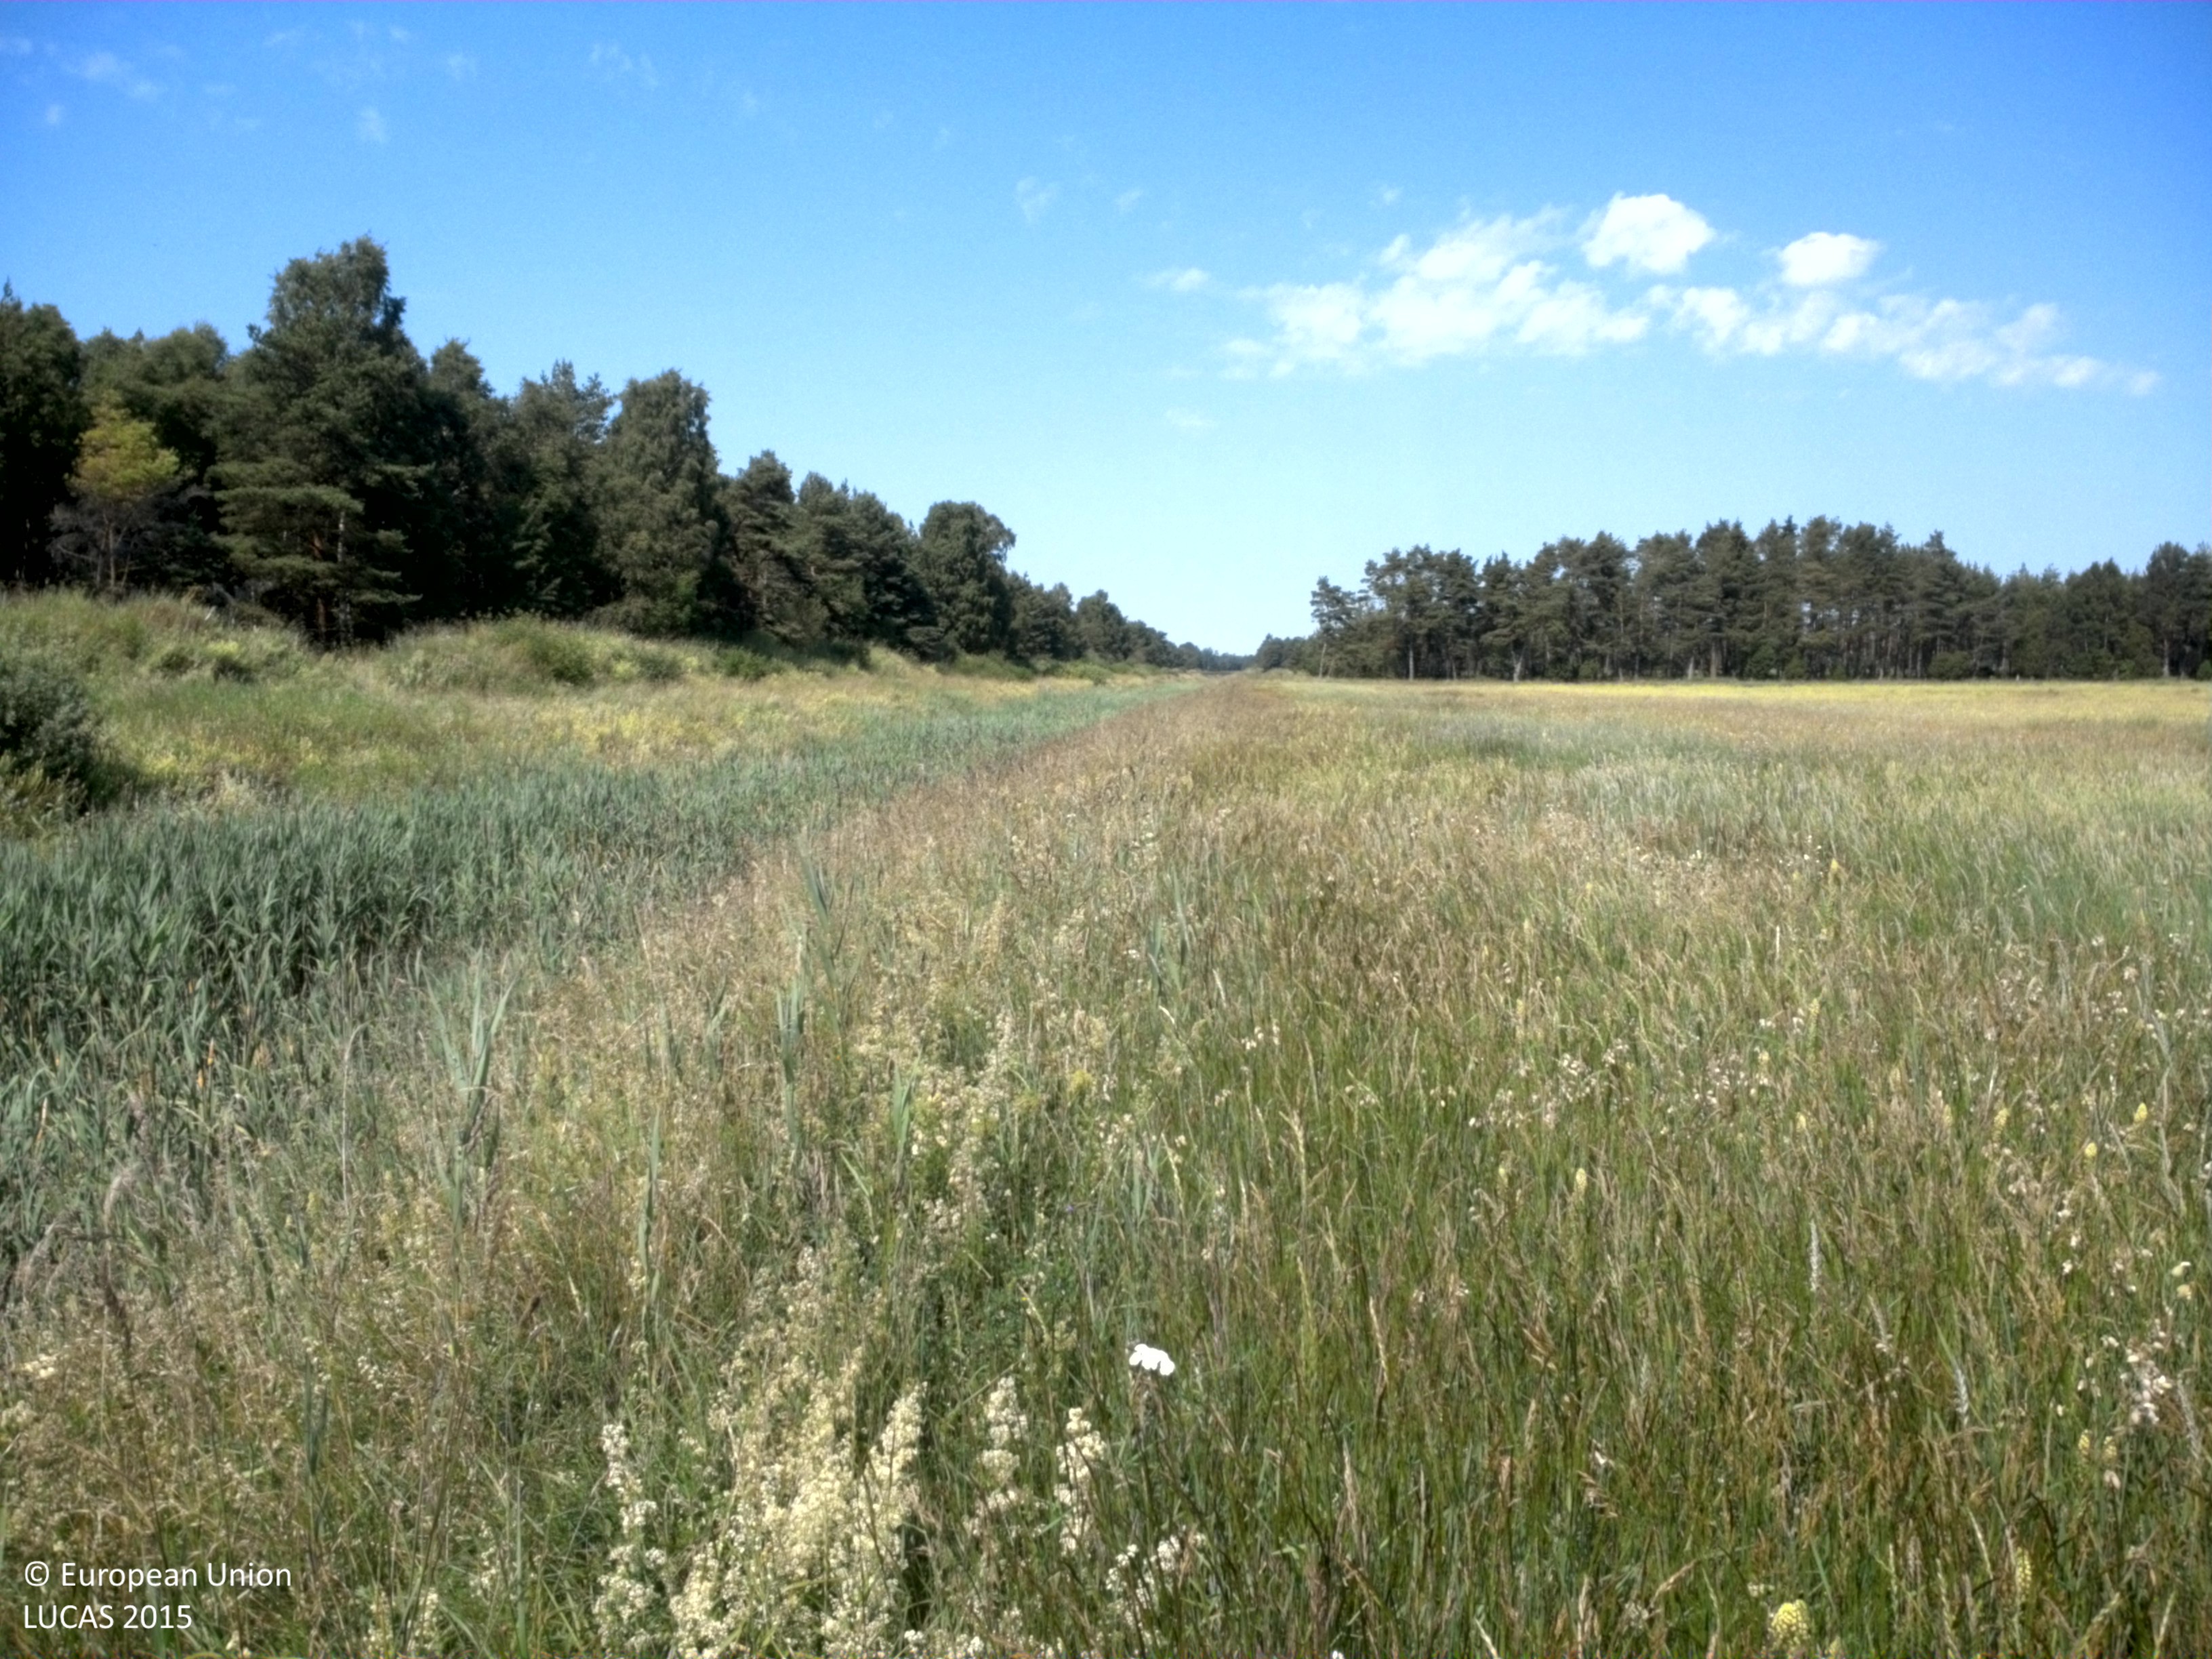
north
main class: Grassland
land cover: Spontaneously vegetated surfaces
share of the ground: > 75 %
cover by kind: herbaceous plants 95 %, shrubs 5 %
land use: Agriculture (excluding fallow land and kitchen gardens)
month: July
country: SE
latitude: 57.7293
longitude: 18.5556
